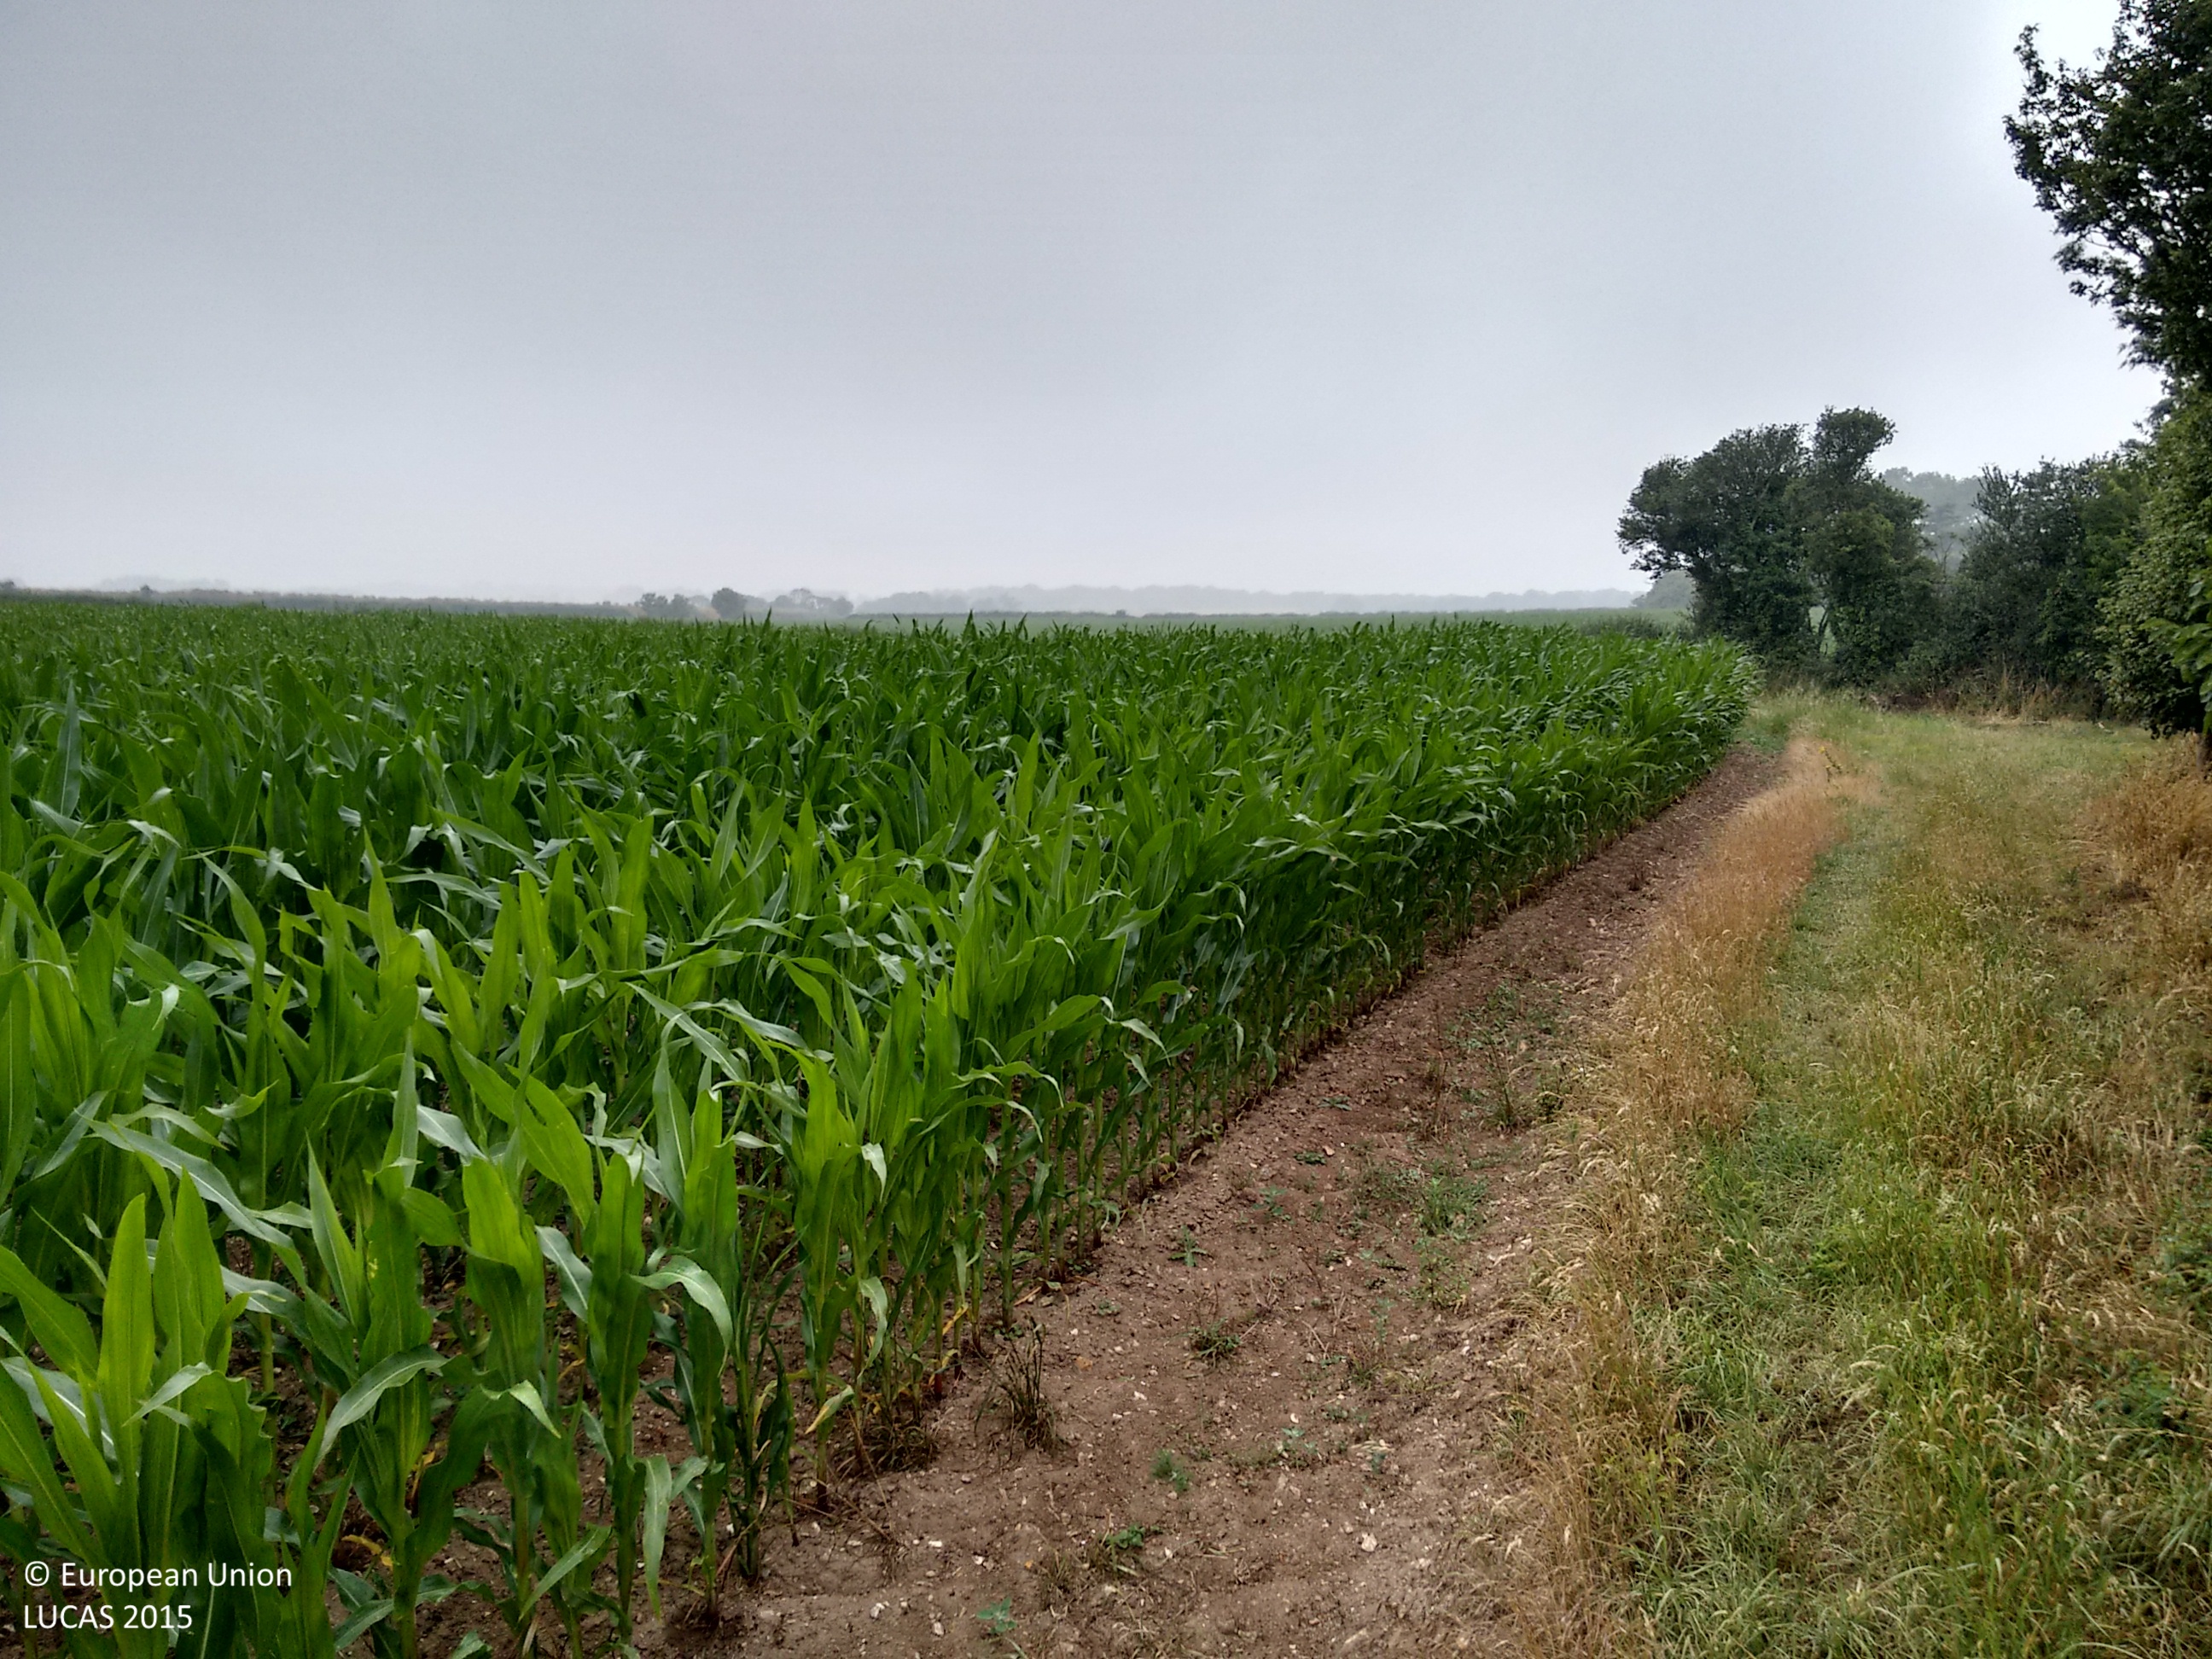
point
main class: Cropland
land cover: Maize
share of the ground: > 75 %
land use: Agriculture (excluding fallow land and kitchen gardens)
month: July
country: GB
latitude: 50.7115
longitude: -2.3418
